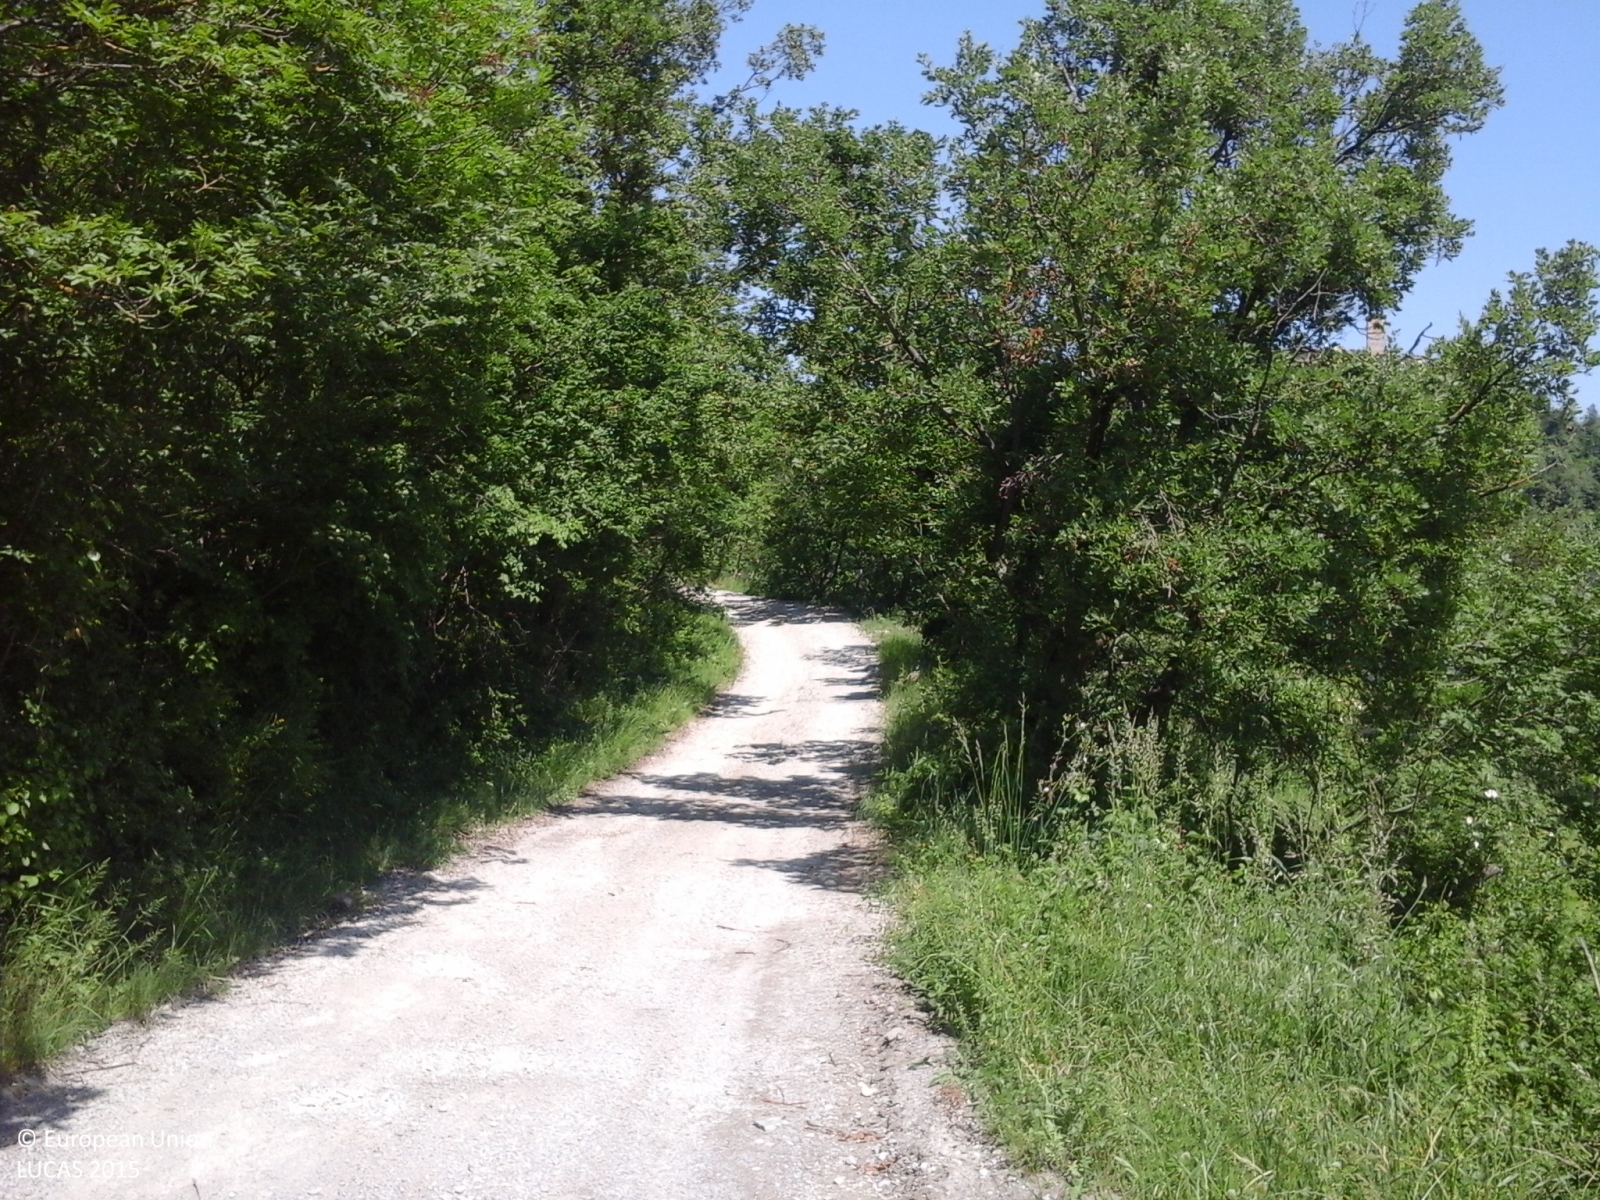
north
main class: Grassland
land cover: Grassland without tree/shrub cover
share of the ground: > 75 %
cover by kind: herbaceous plants 100 %
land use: Agriculture (excluding fallow land and kitchen gardens)
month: May
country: IT
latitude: 44.4006
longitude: 10.9145
